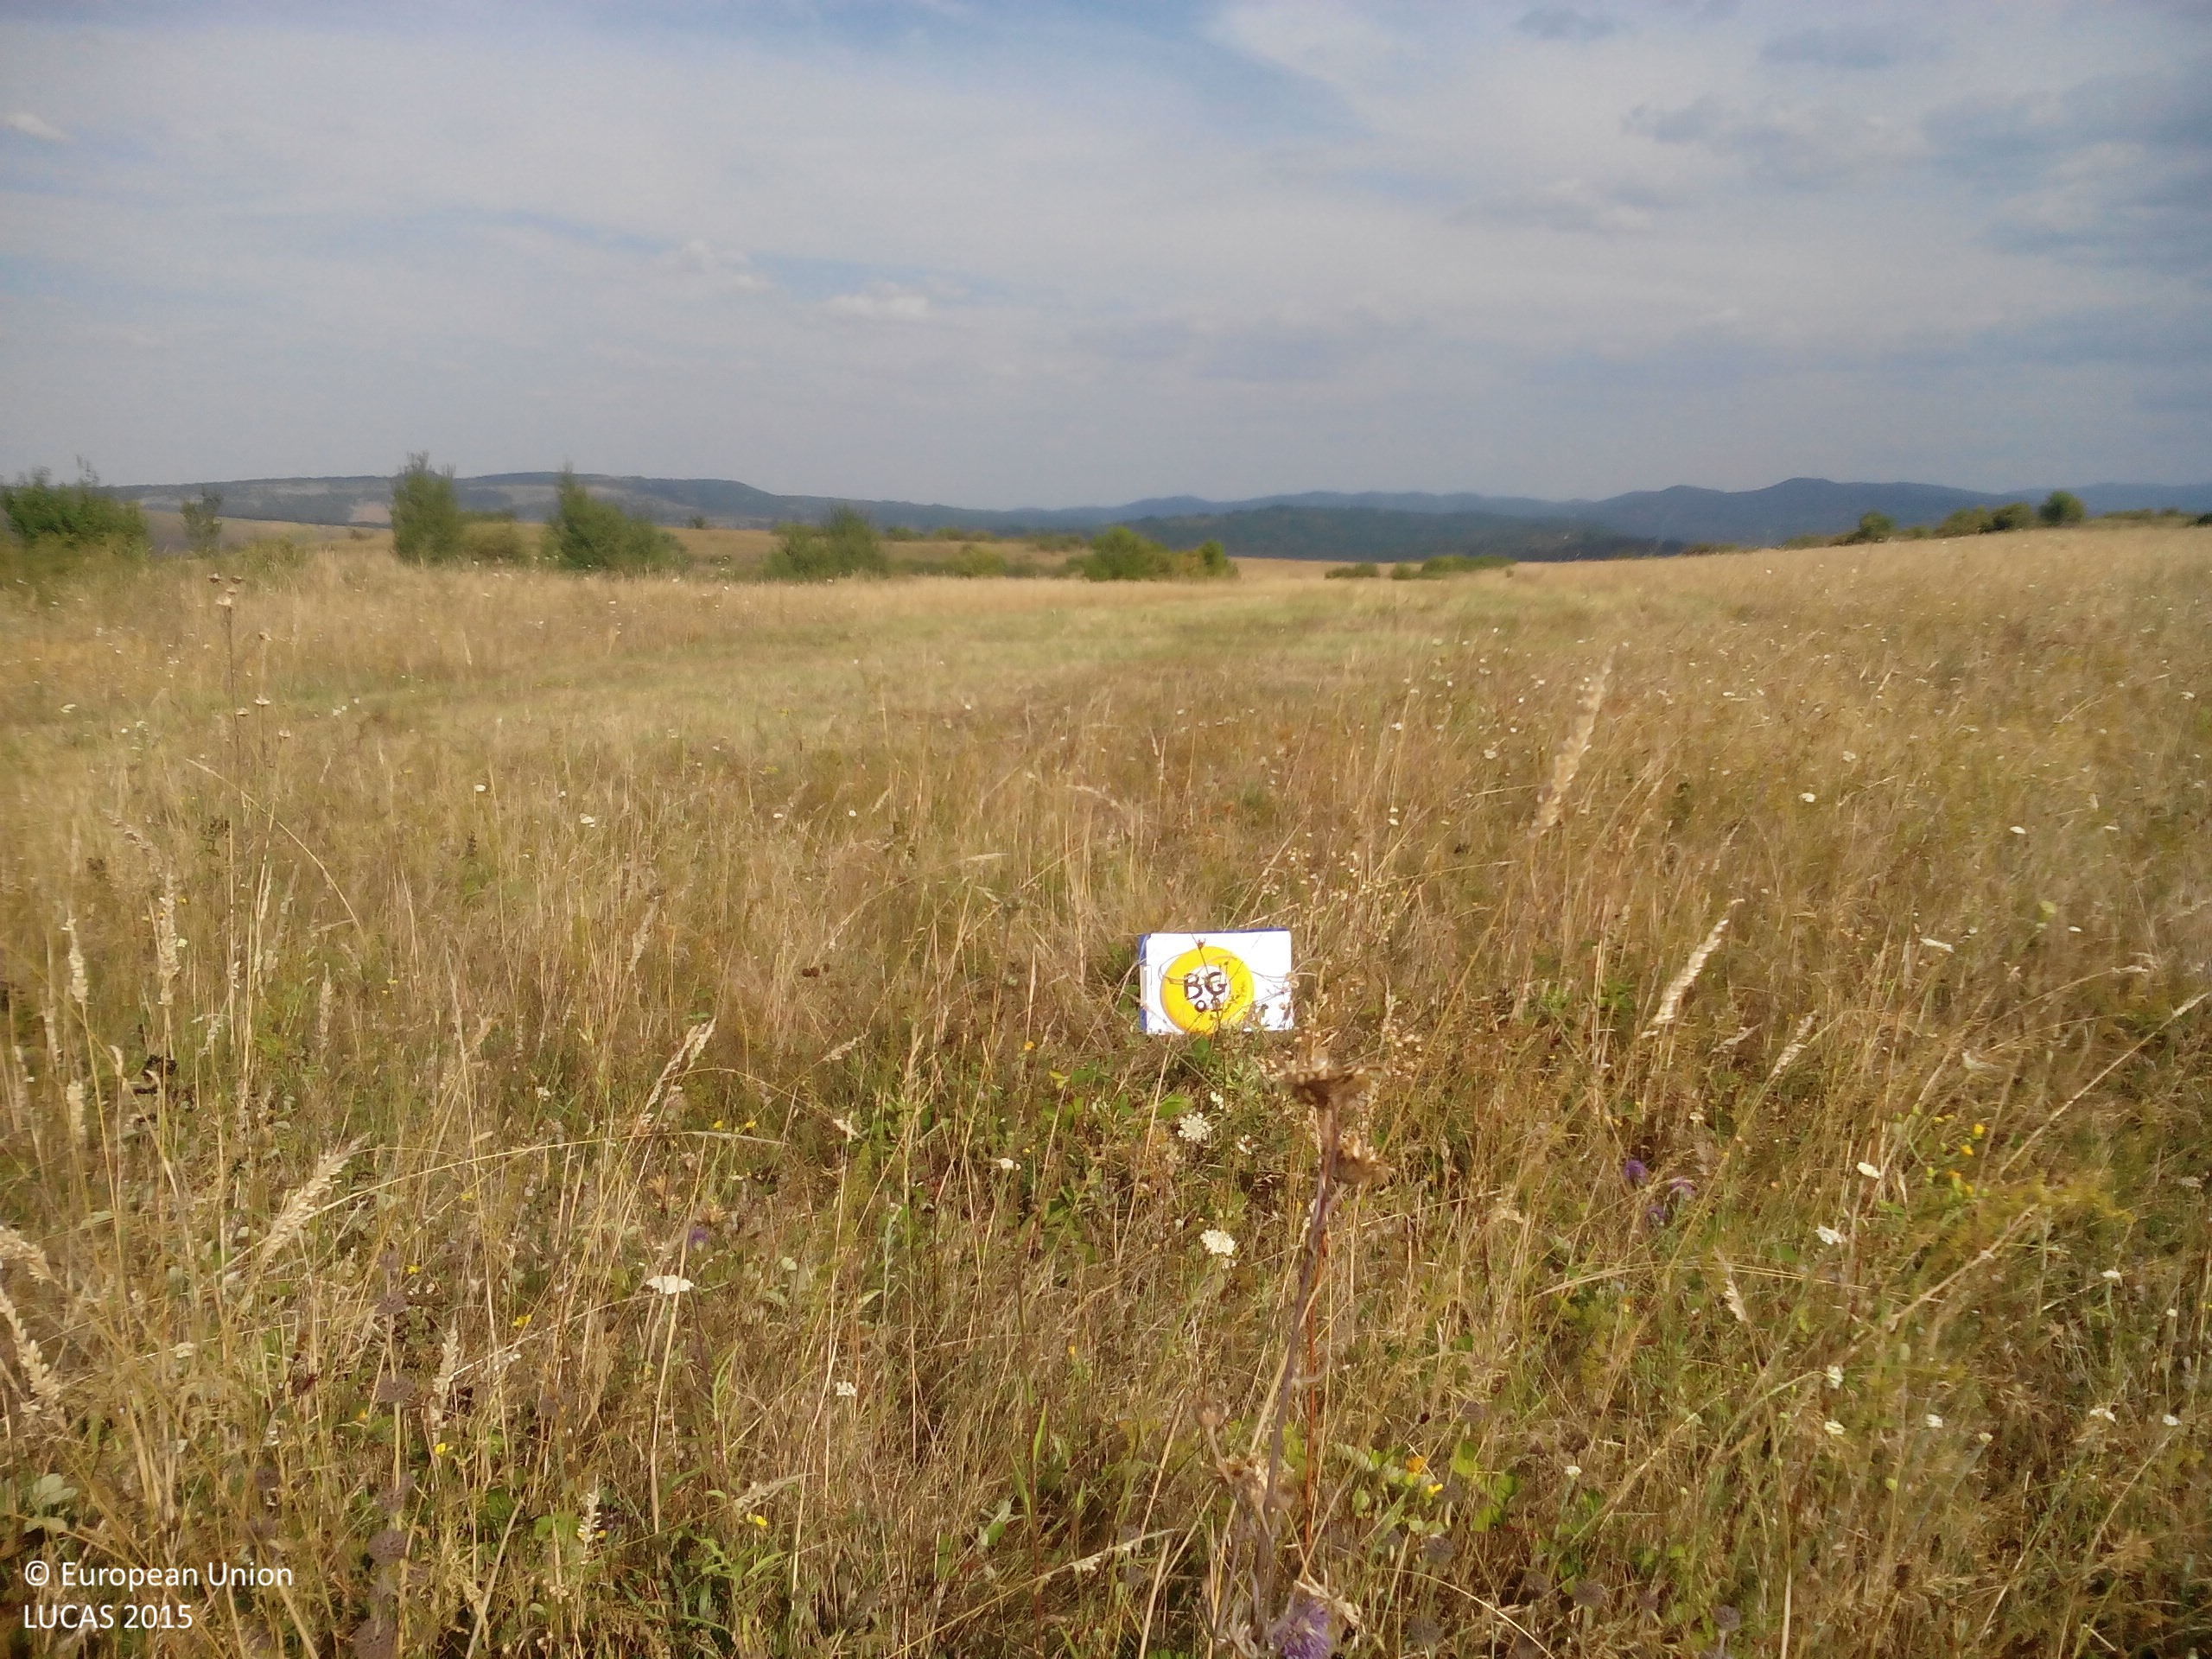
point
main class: Grassland
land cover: Grassland without tree/shrub cover
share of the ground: > 75 %
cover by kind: herbaceous plants 100 %
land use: Agriculture (excluding fallow land and kitchen gardens)
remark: Harvested field
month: August
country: BG
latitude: 43.1529
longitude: 23.9068
